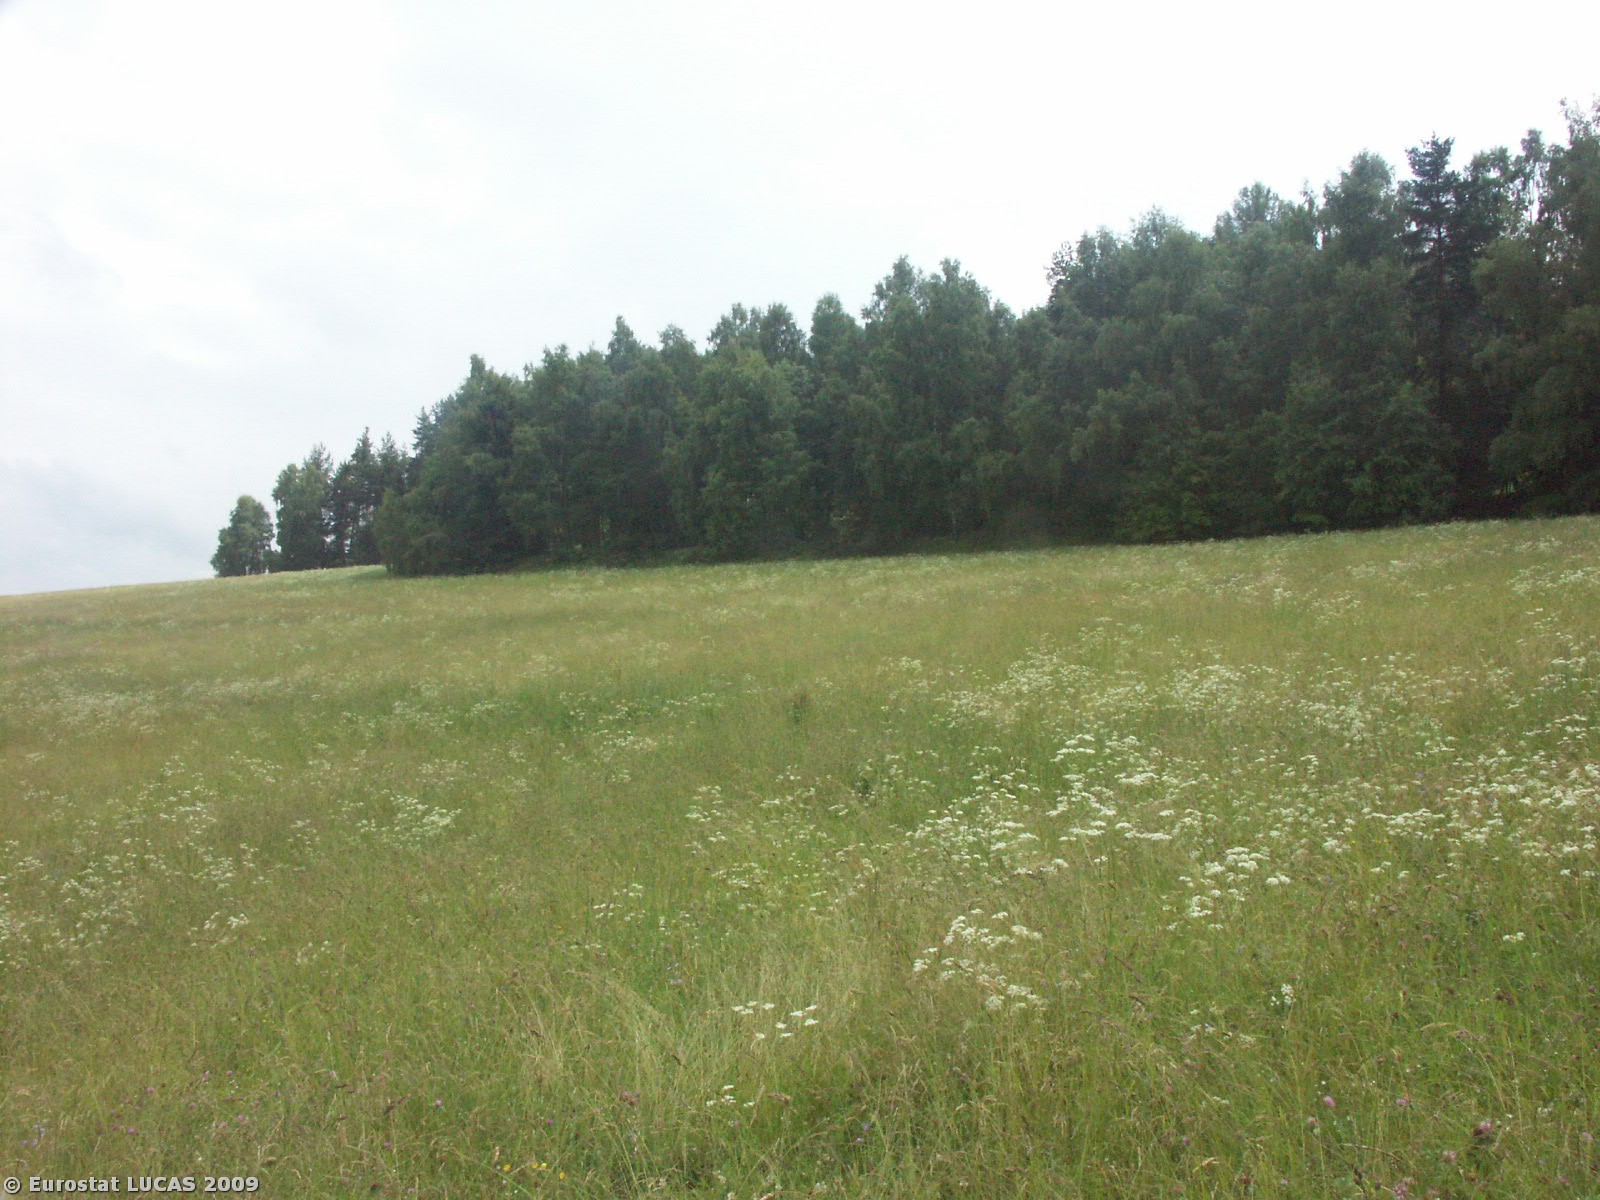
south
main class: Grassland
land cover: Grassland without tree/shrub cover
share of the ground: > 75 %
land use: Agriculture (excluding fallow land and kitchen gardens)
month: June
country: CZ
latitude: 48.7159
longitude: 14.3091
